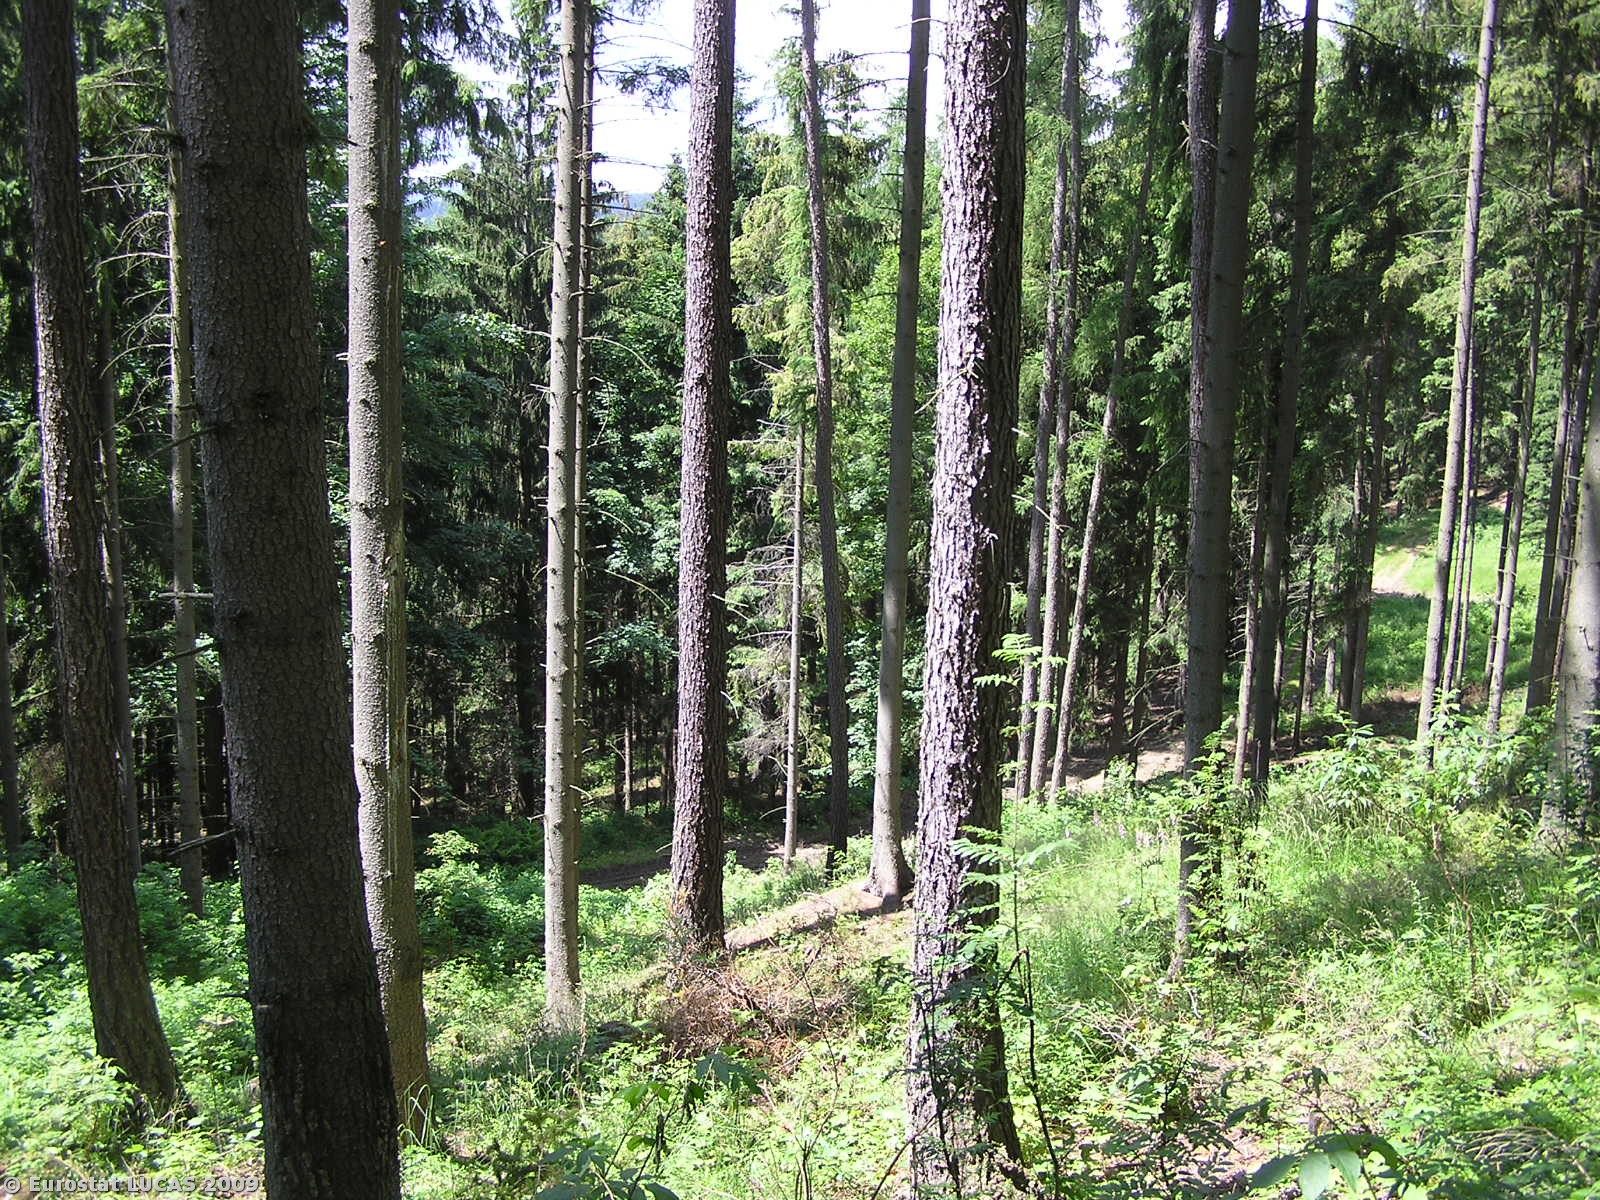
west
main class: Woodland
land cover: Coniferous woodland
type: hemiboreal forest and nemoral coniferous forest and mixed broadleaved-coniferous forest
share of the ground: > 75 %
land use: Forestry
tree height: > 5 m
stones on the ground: 10 - 25 %
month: July
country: CZ
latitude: 50.0717
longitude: 17.3750
